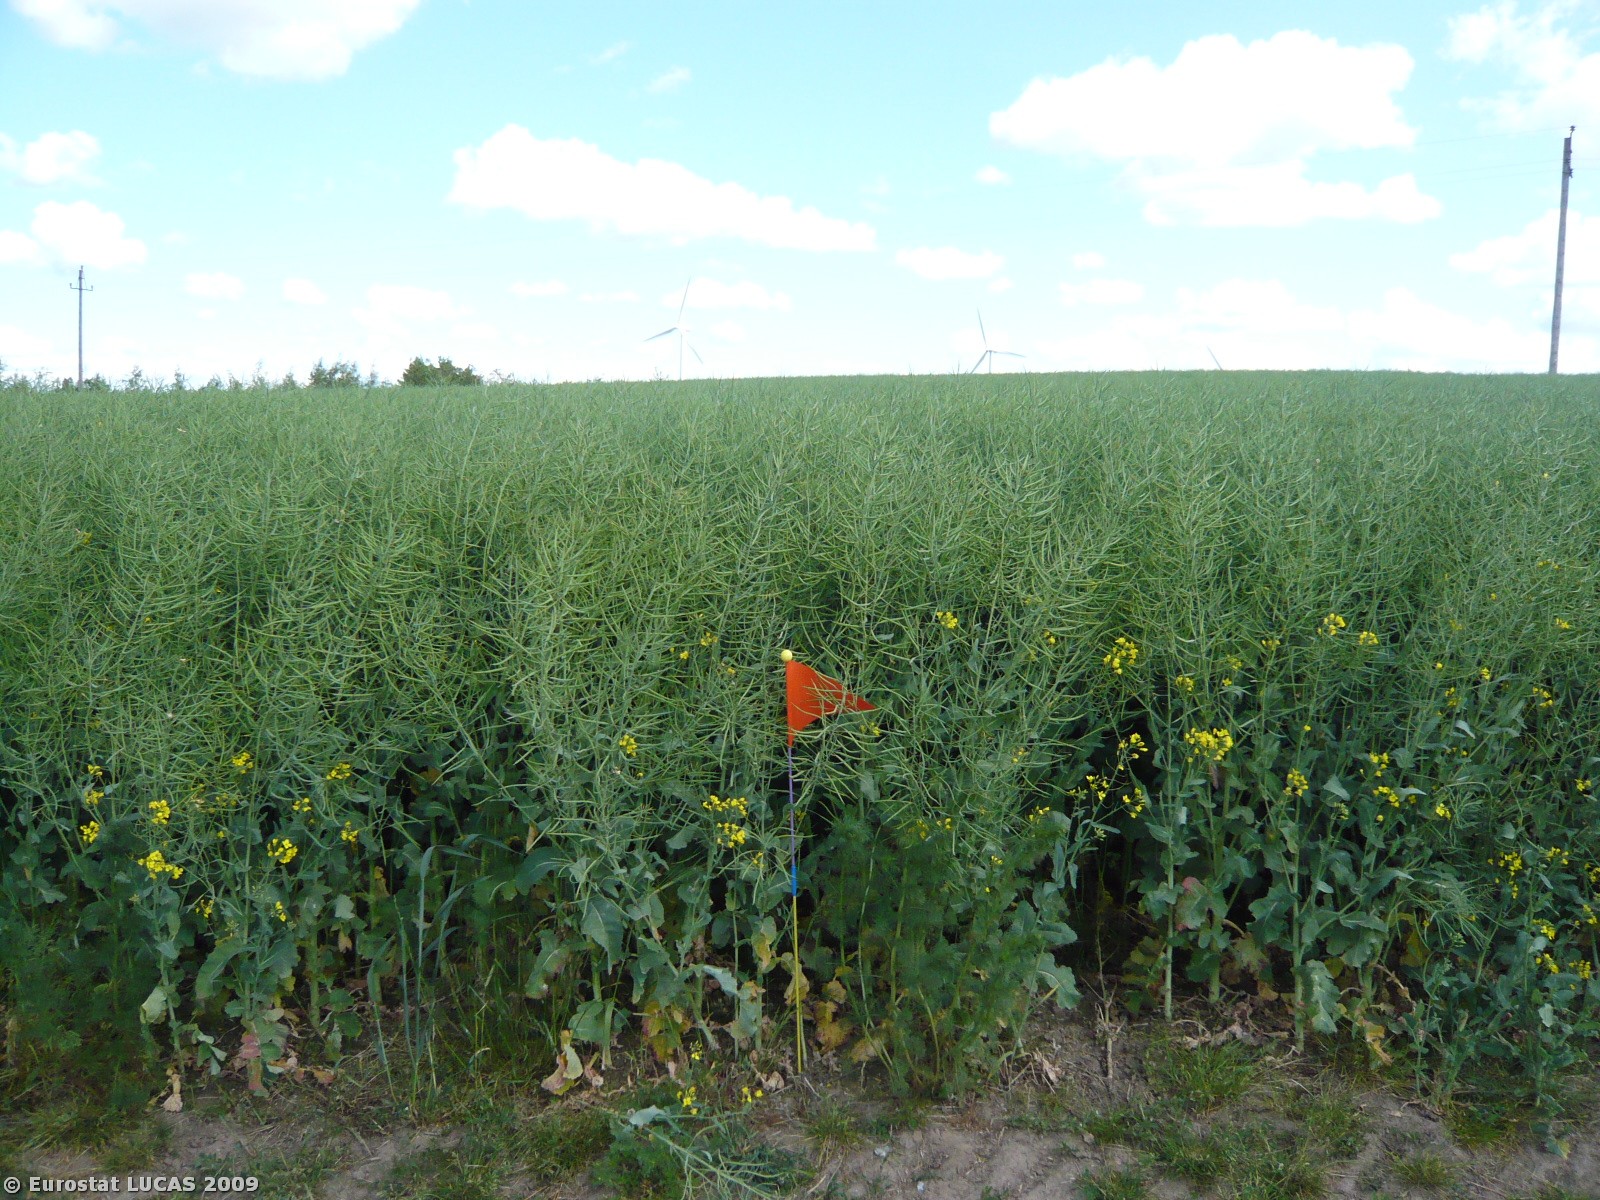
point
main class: Cropland
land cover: Rape and turnip rape
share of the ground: > 75 %
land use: Agriculture (excluding fallow land and kitchen gardens)
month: June
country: DK
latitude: 55.3179
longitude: 11.3383
